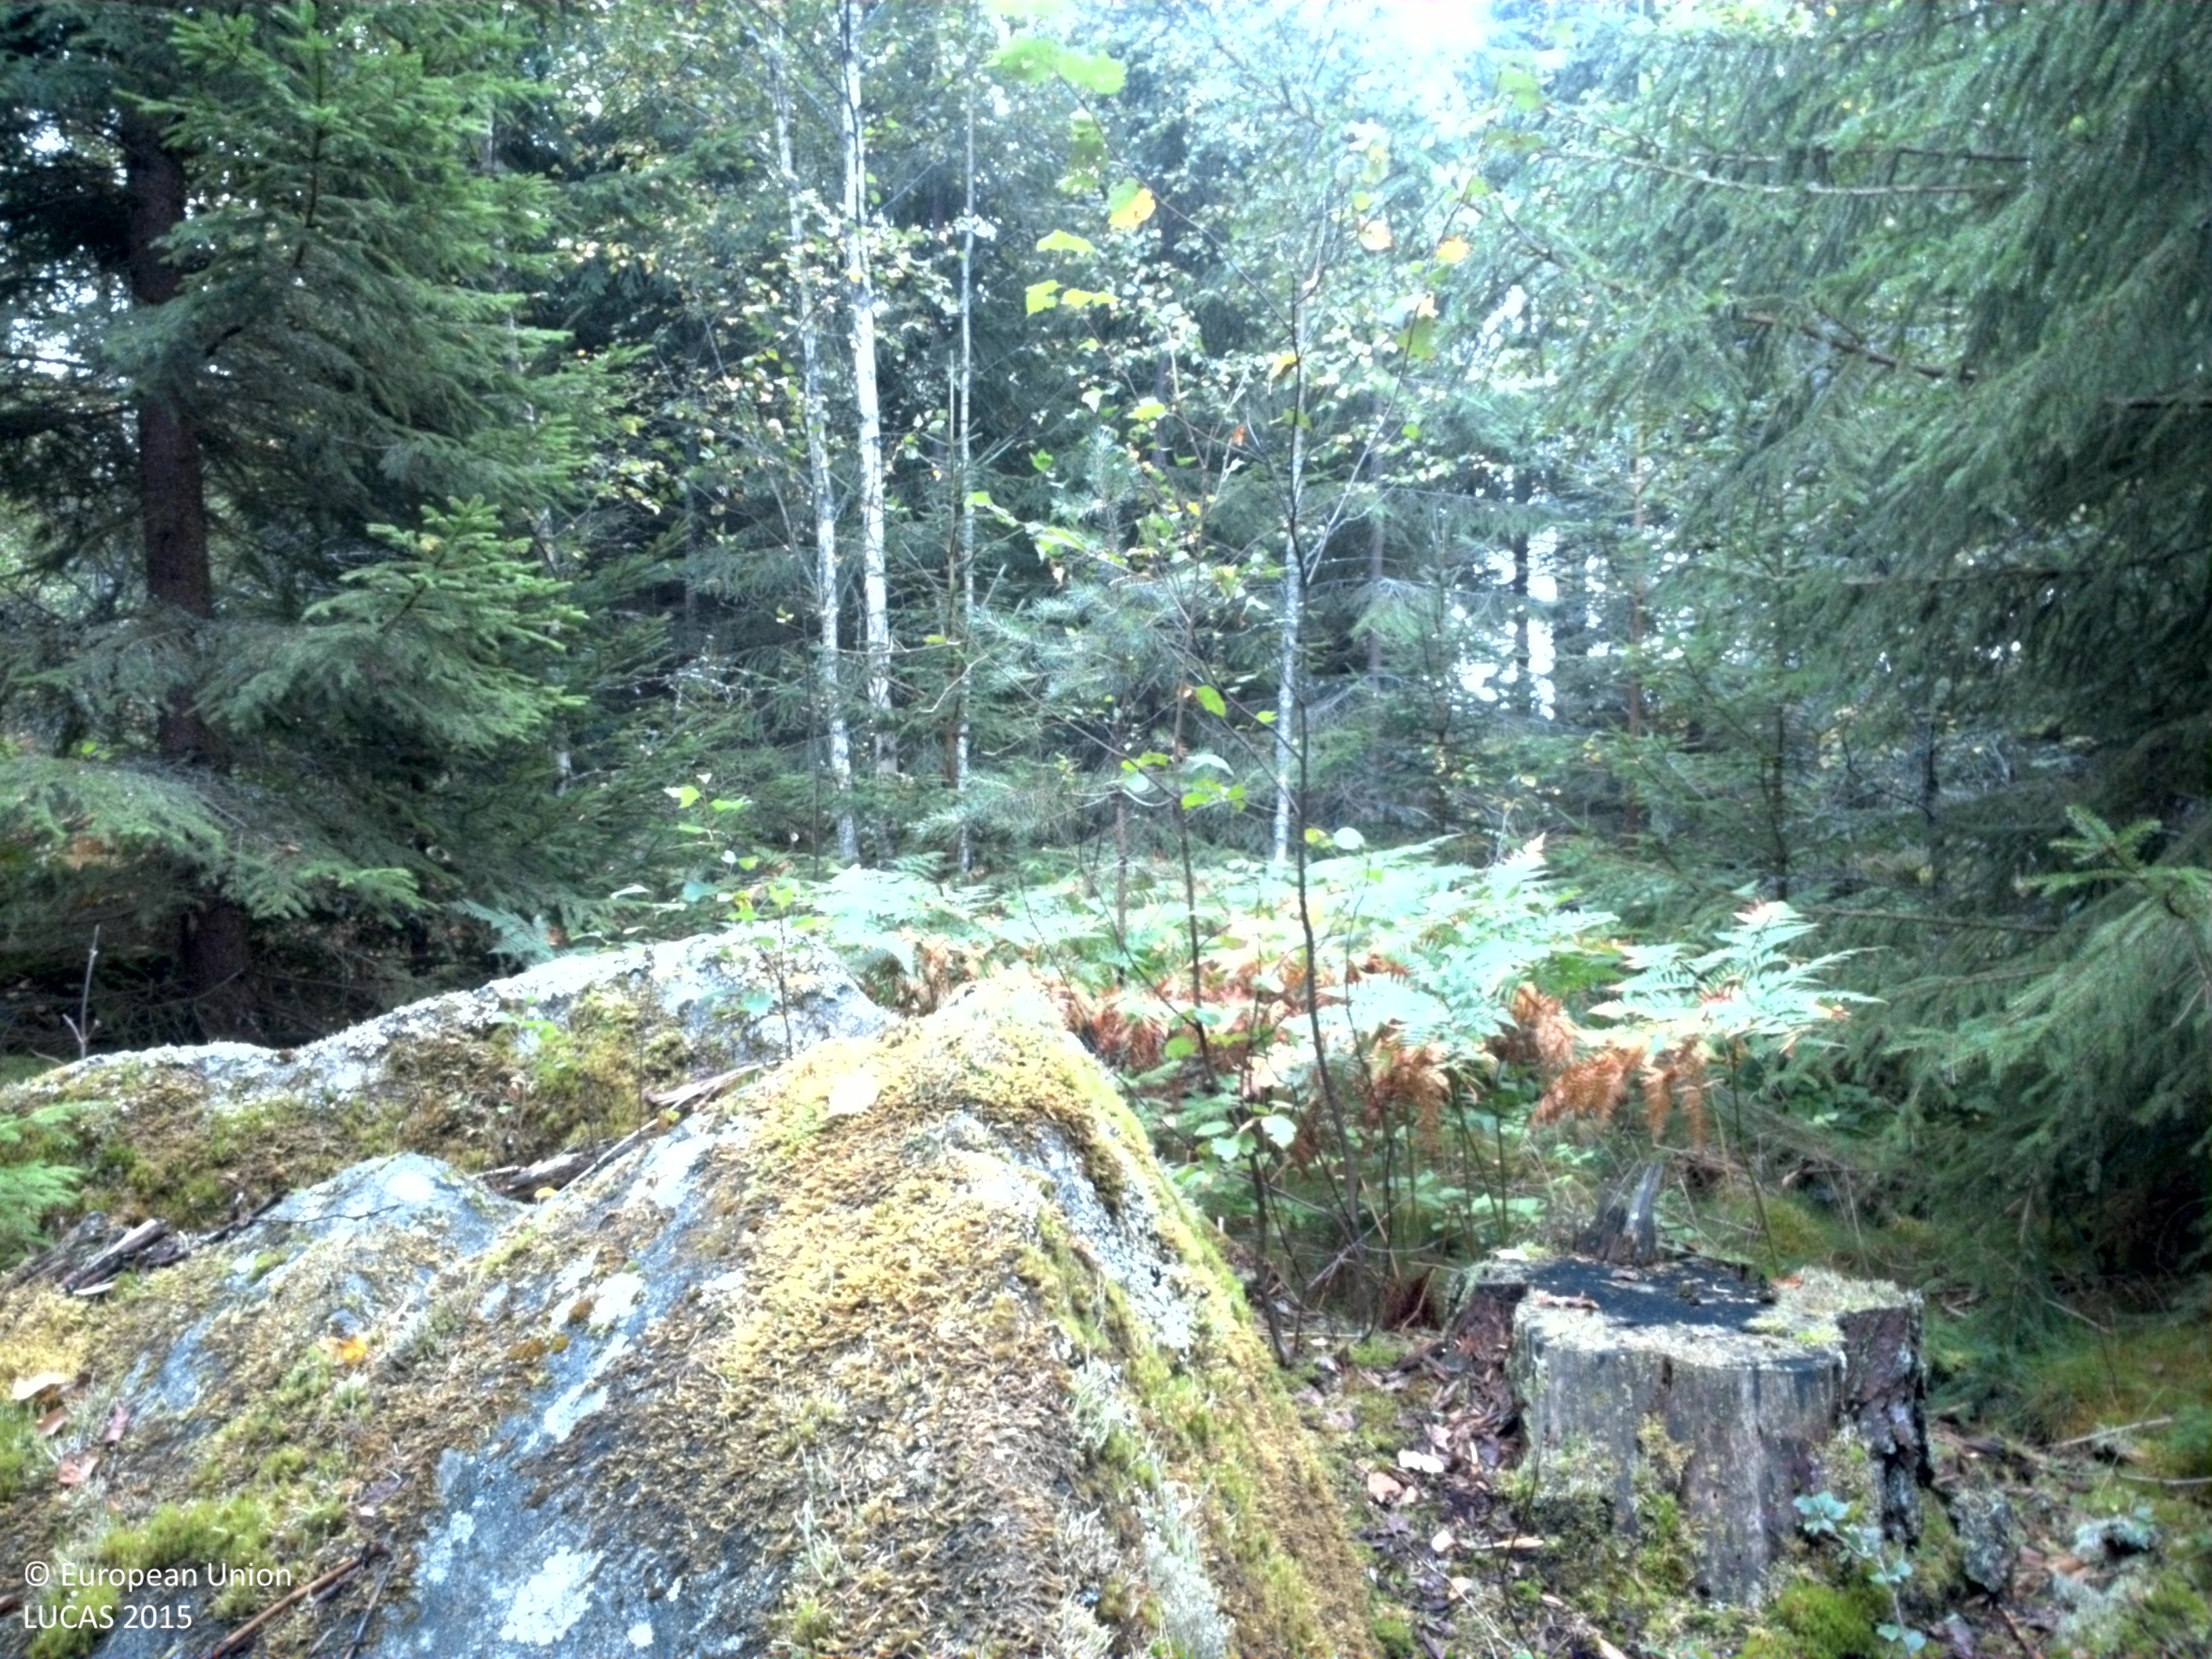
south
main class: Woodland
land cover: Spruce dominated coniferous woodland
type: boreal forest
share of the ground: > 75 %
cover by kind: coniferous forest trees 75 %, lichens and mosses 20 %, broadleaved forest trees 5 %
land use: Forestry
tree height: > 5 m
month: August
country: SE
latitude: 59.9892
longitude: 17.6835
